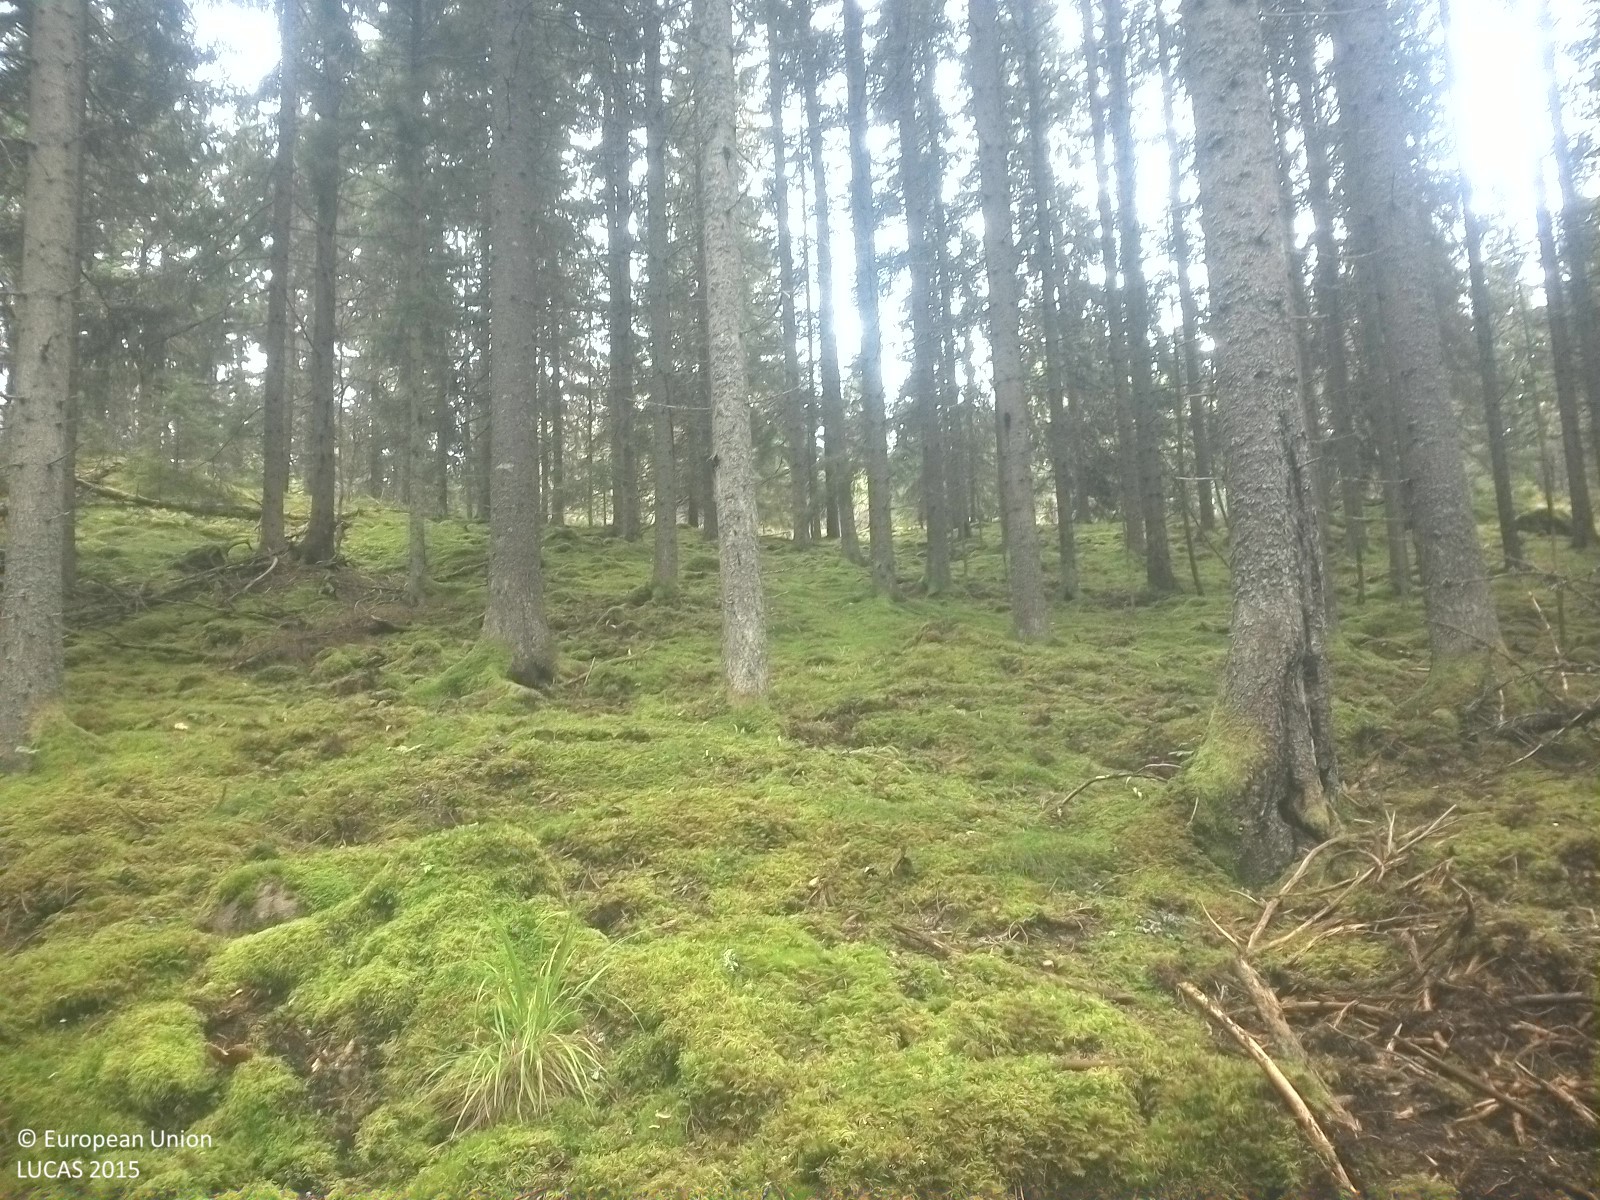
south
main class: Woodland
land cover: Spruce dominated coniferous woodland
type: boreal forest
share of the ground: 25 - 50 %
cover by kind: coniferous forest trees 40 %, lichens and mosses 30 %, herbaceous plants 25 %, broadleaved forest trees 5 %
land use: Forestry
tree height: > 5 m
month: September
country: SE
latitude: 58.7998
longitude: 15.7569
